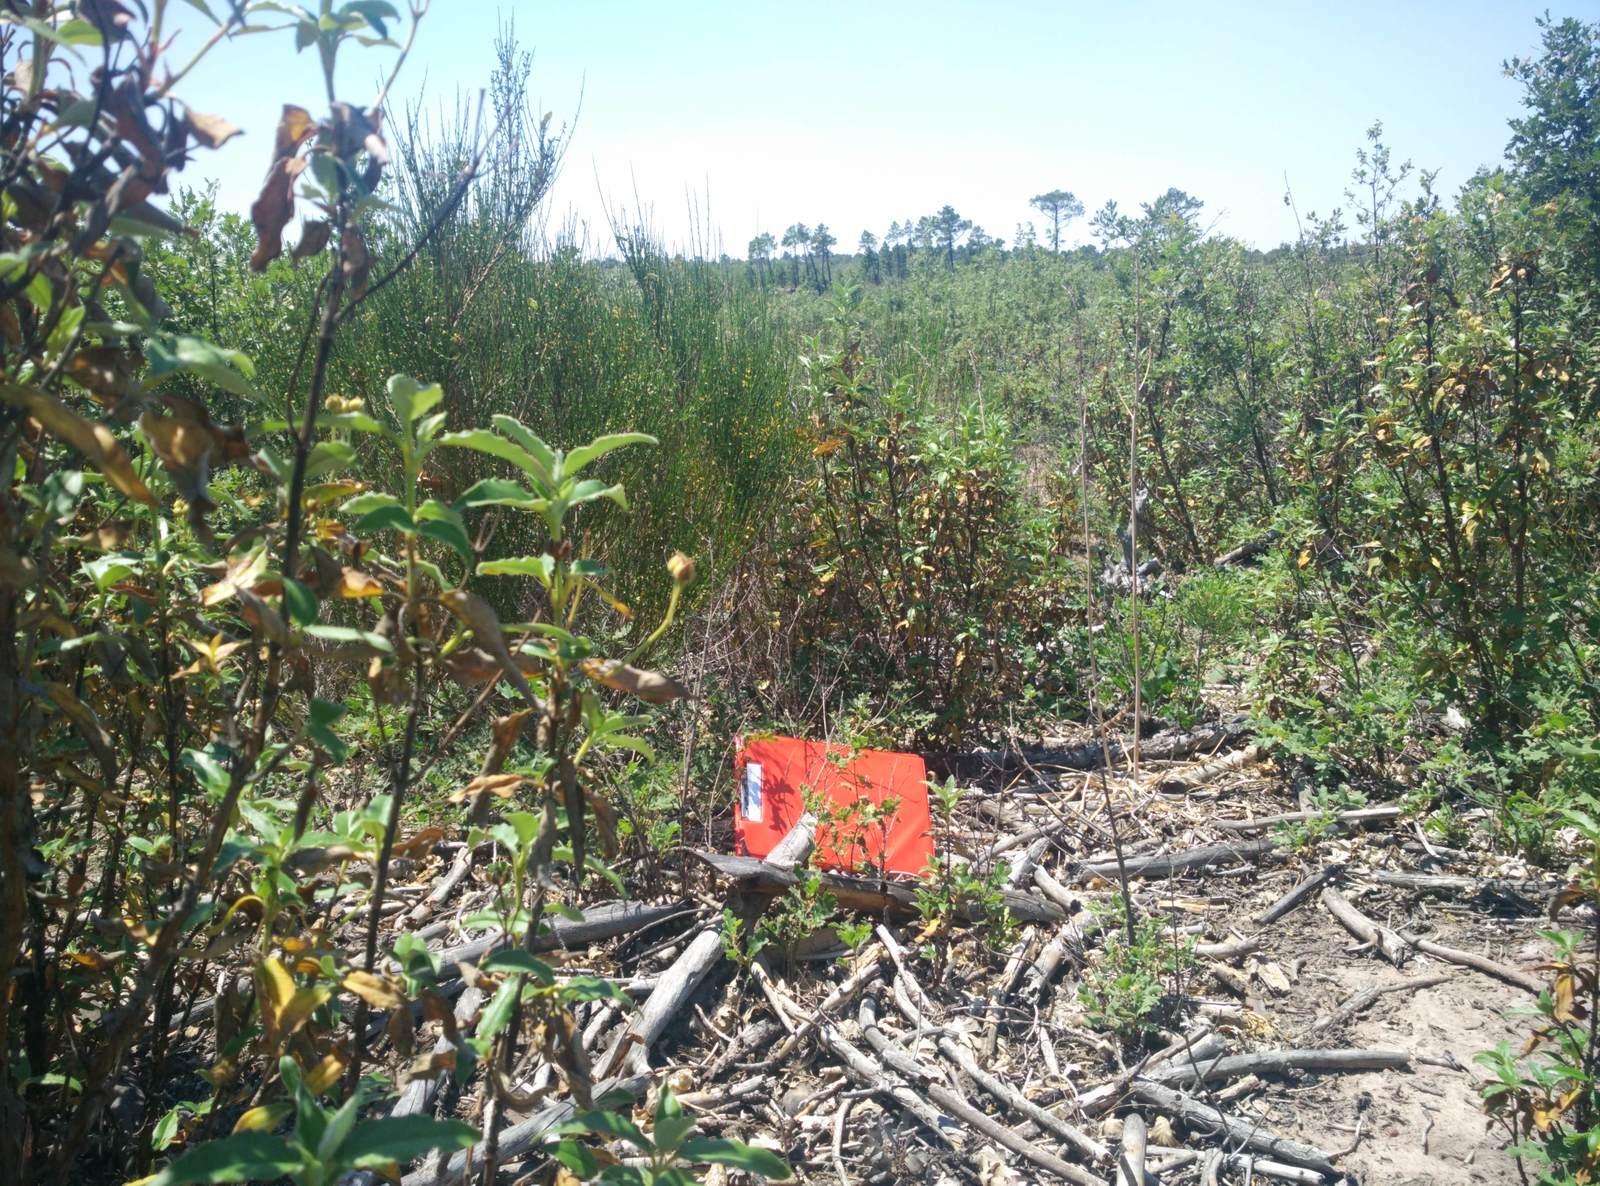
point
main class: Shrubland
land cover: Shrubland without tree cover
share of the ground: > 75 %
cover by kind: shrubs 80 %, unconsolidated bare surface 15 %, herbaceous plants 5 %
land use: Semi-natural and natural areas not in use
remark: Burnt area
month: July
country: ES
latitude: 40.9011
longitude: -2.1214
